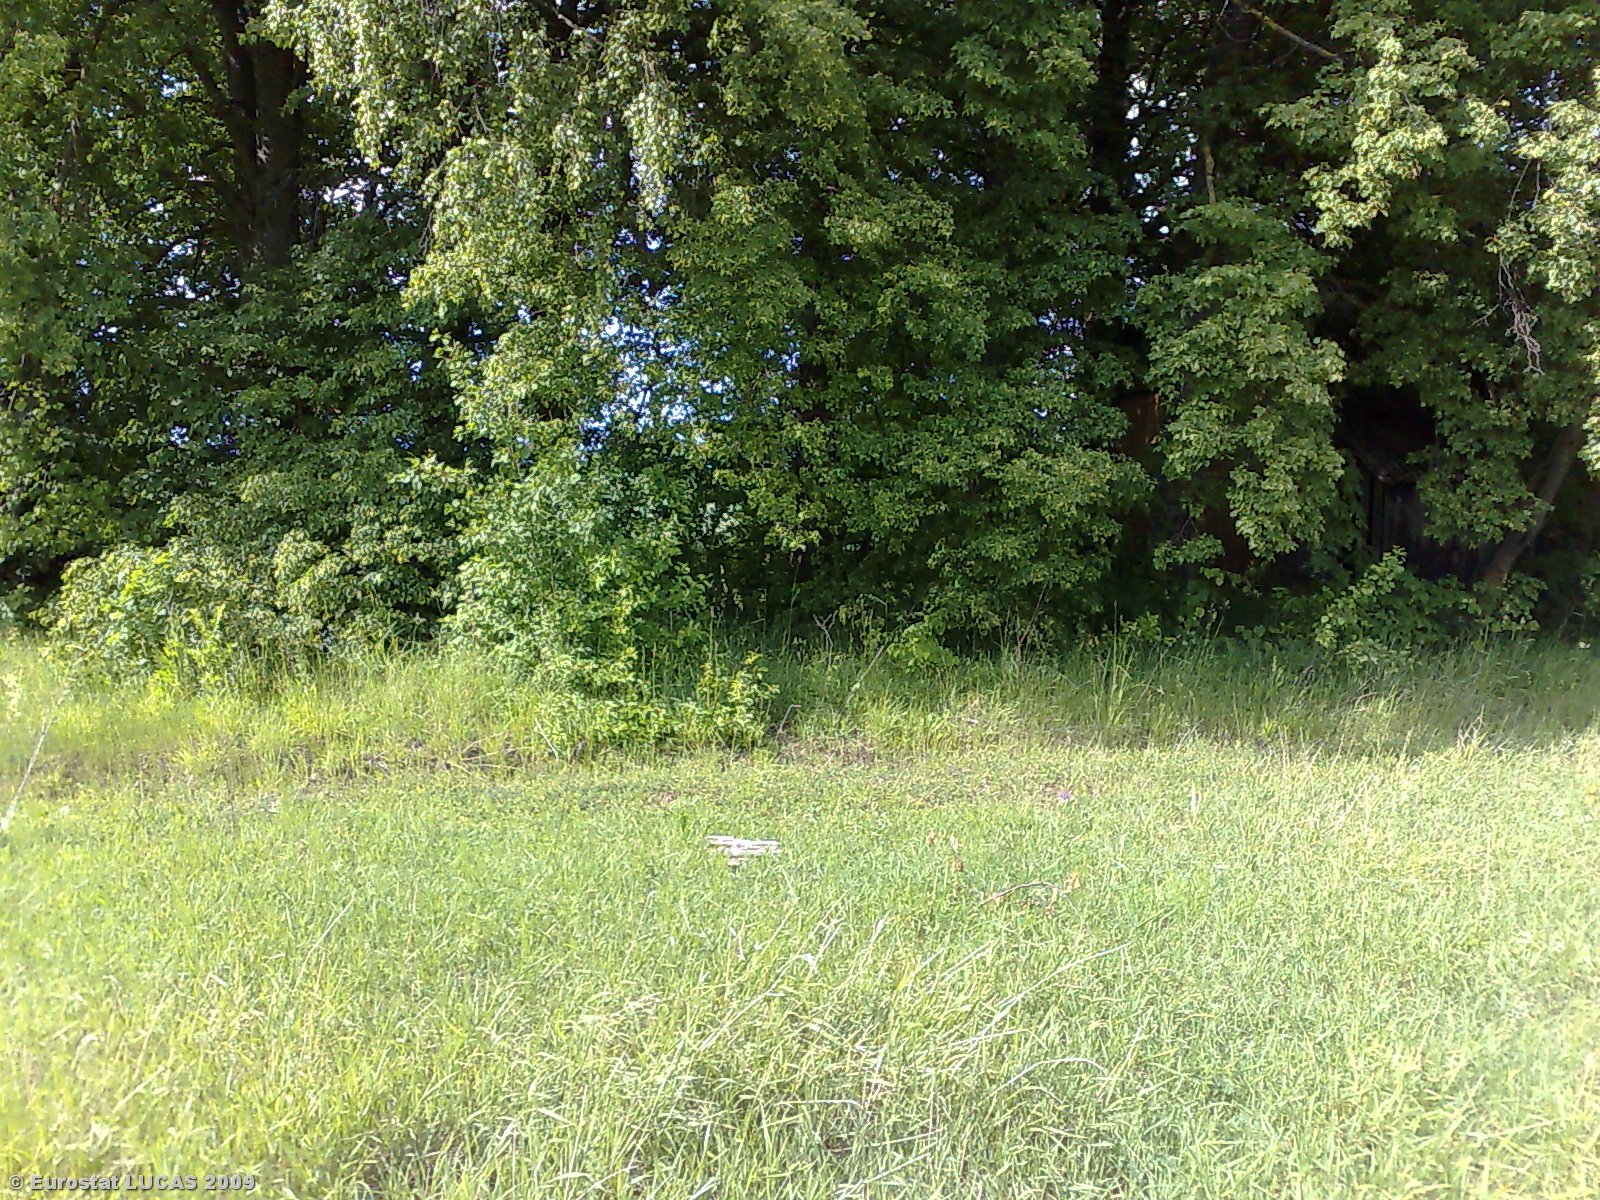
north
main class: Grassland
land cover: Grassland without tree/shrub cover
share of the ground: > 75 %
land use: Agriculture (excluding fallow land and kitchen gardens)
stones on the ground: < 10 %
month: June
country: LT
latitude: 56.0961
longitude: 24.1227
